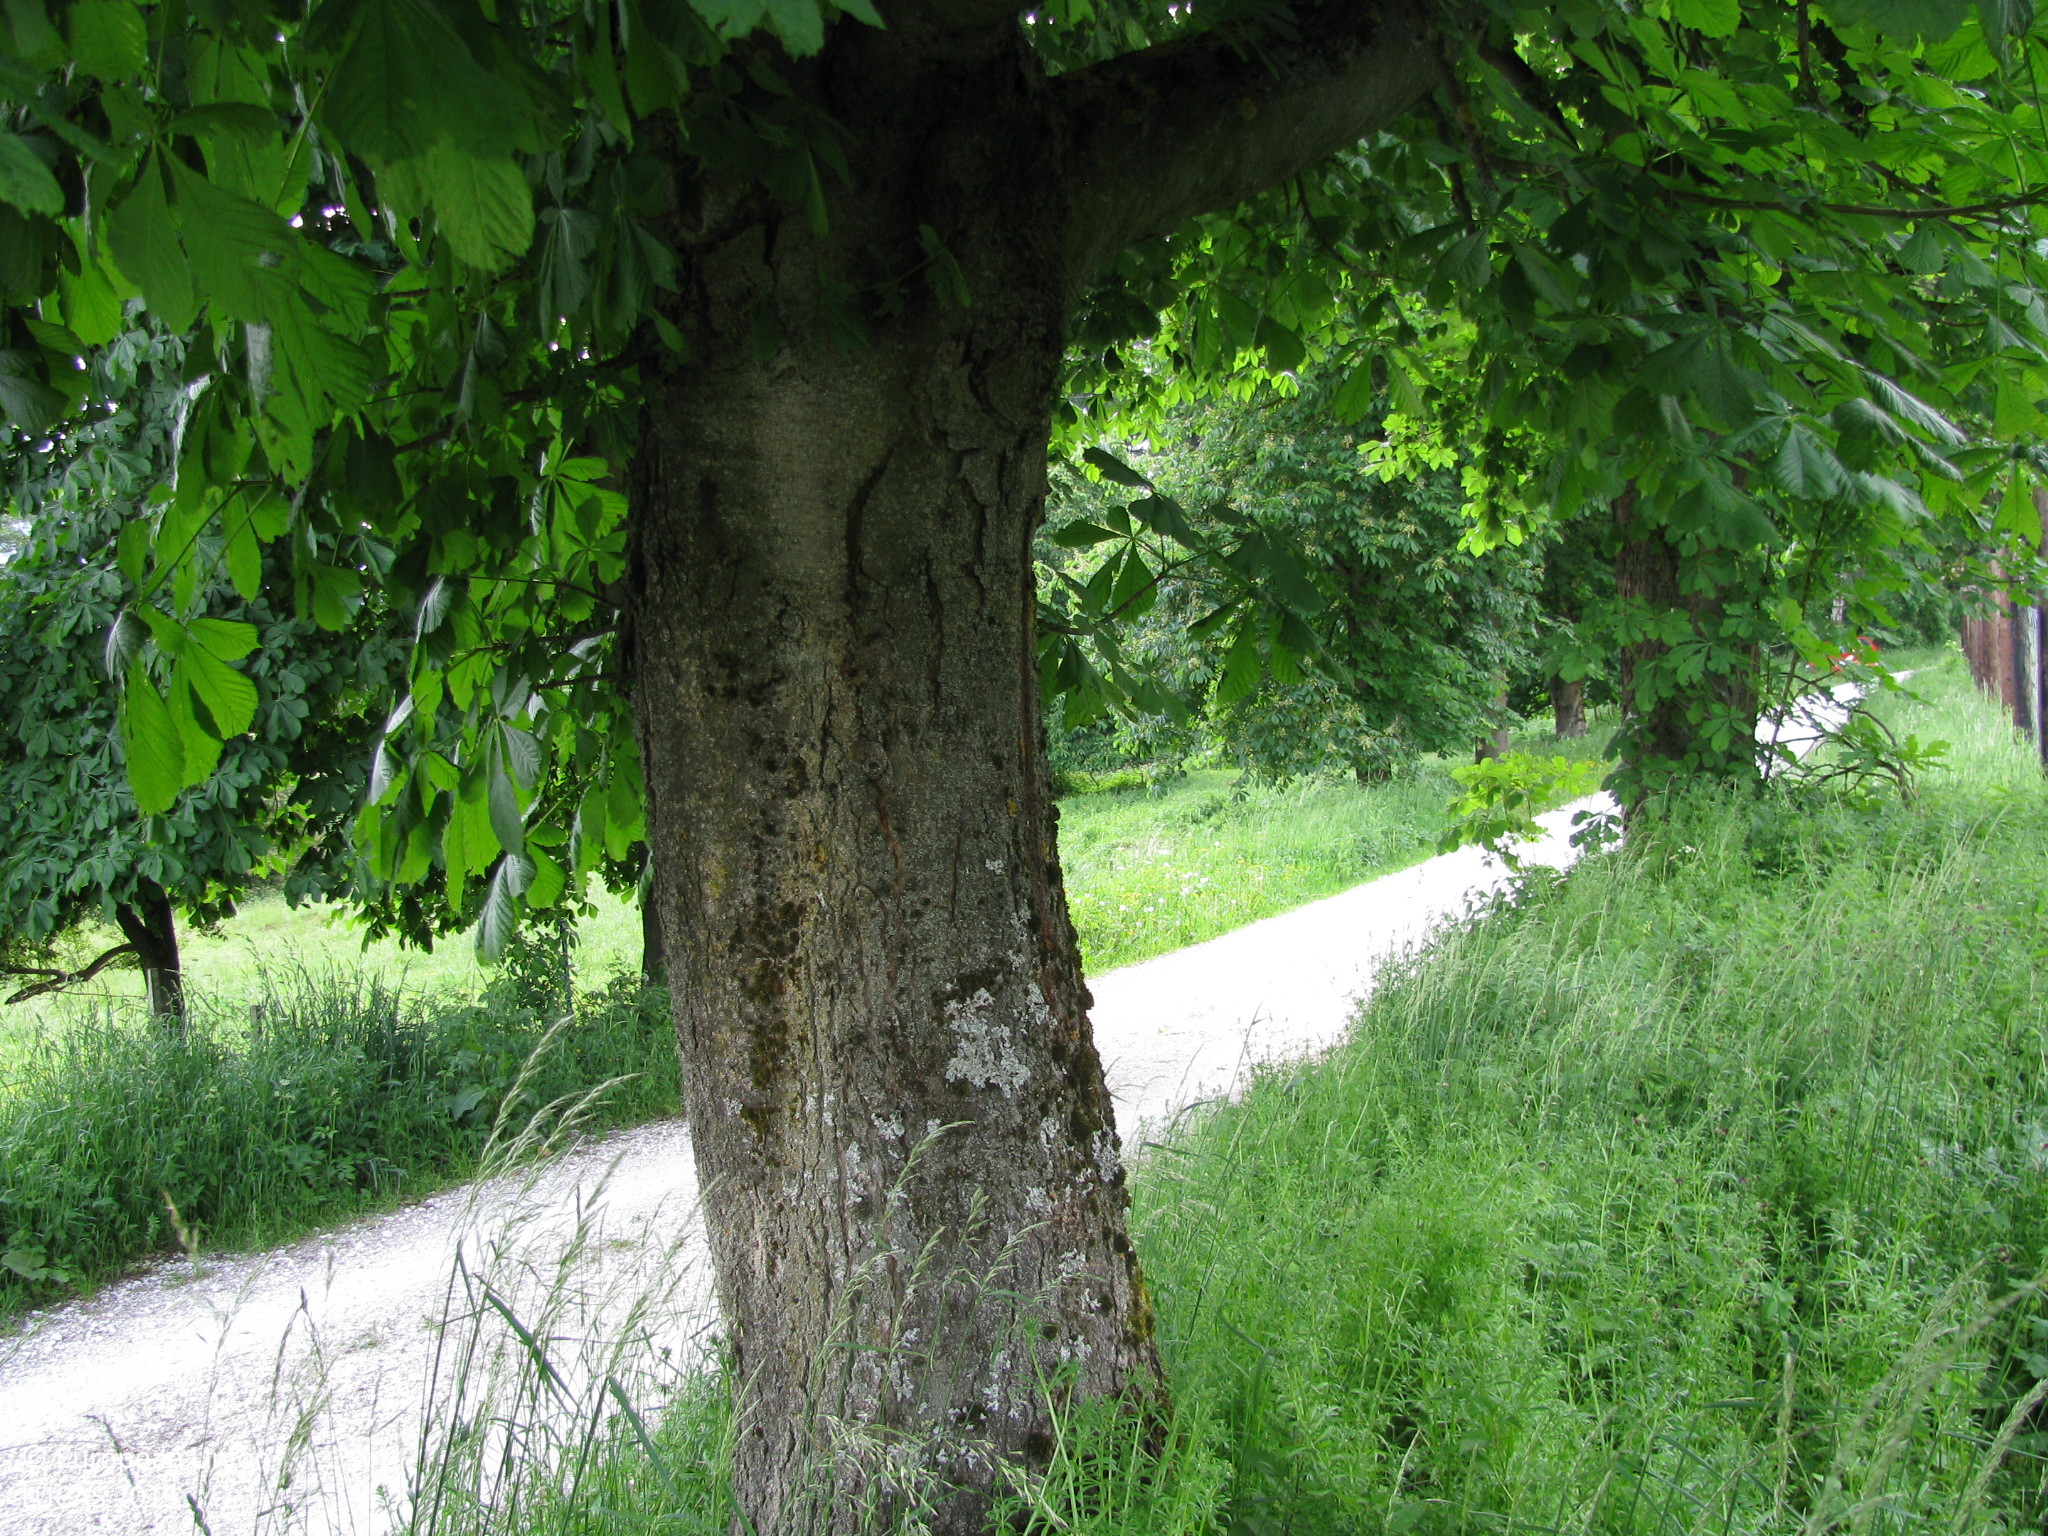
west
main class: Grassland
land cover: Grassland without tree/shrub cover
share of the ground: > 75 %
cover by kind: herbaceous plants 100 %
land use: Agriculture (excluding fallow land and kitchen gardens)
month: June
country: AT
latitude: 47.3939
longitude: 14.8883
